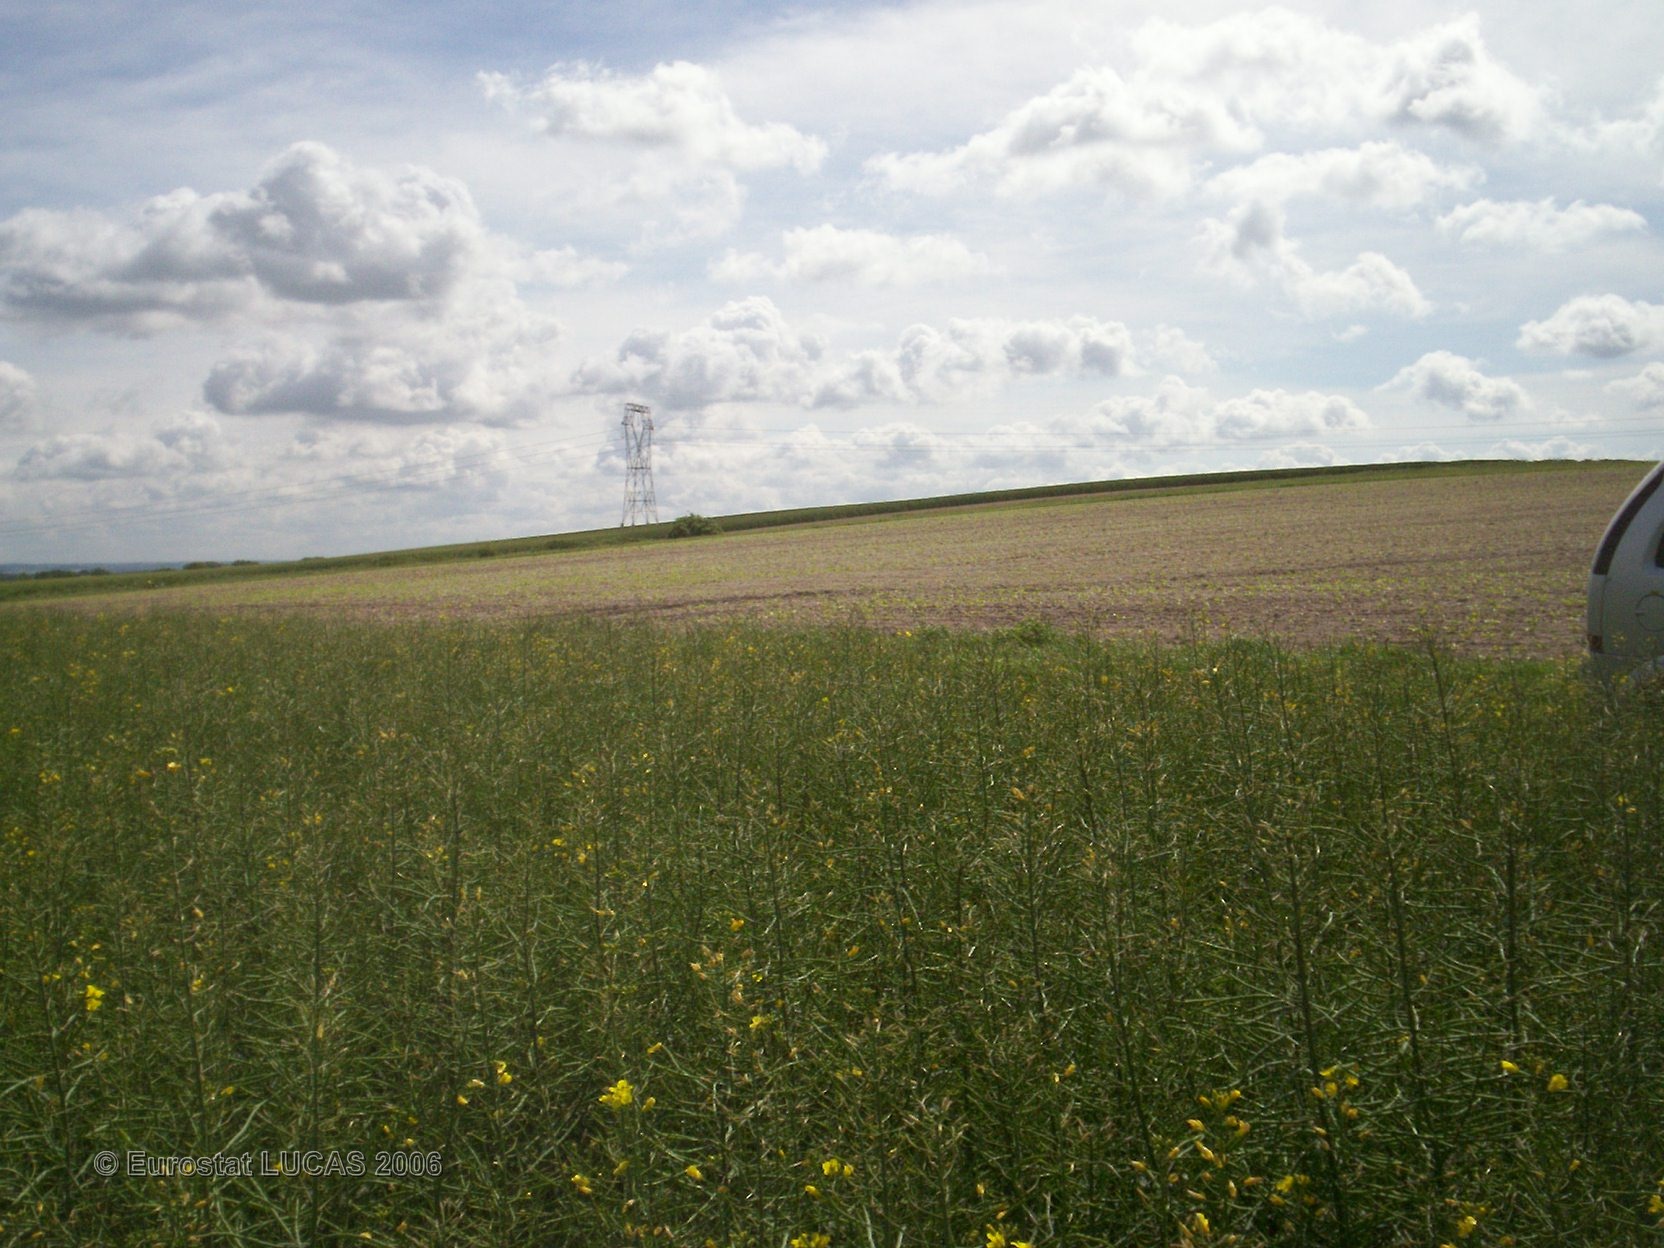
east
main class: Cropland
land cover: Rape and turnip rape
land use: Agriculture (excluding fallow land and kitchen gardens)
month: May
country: FR
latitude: 49.4715
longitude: 4.4347
